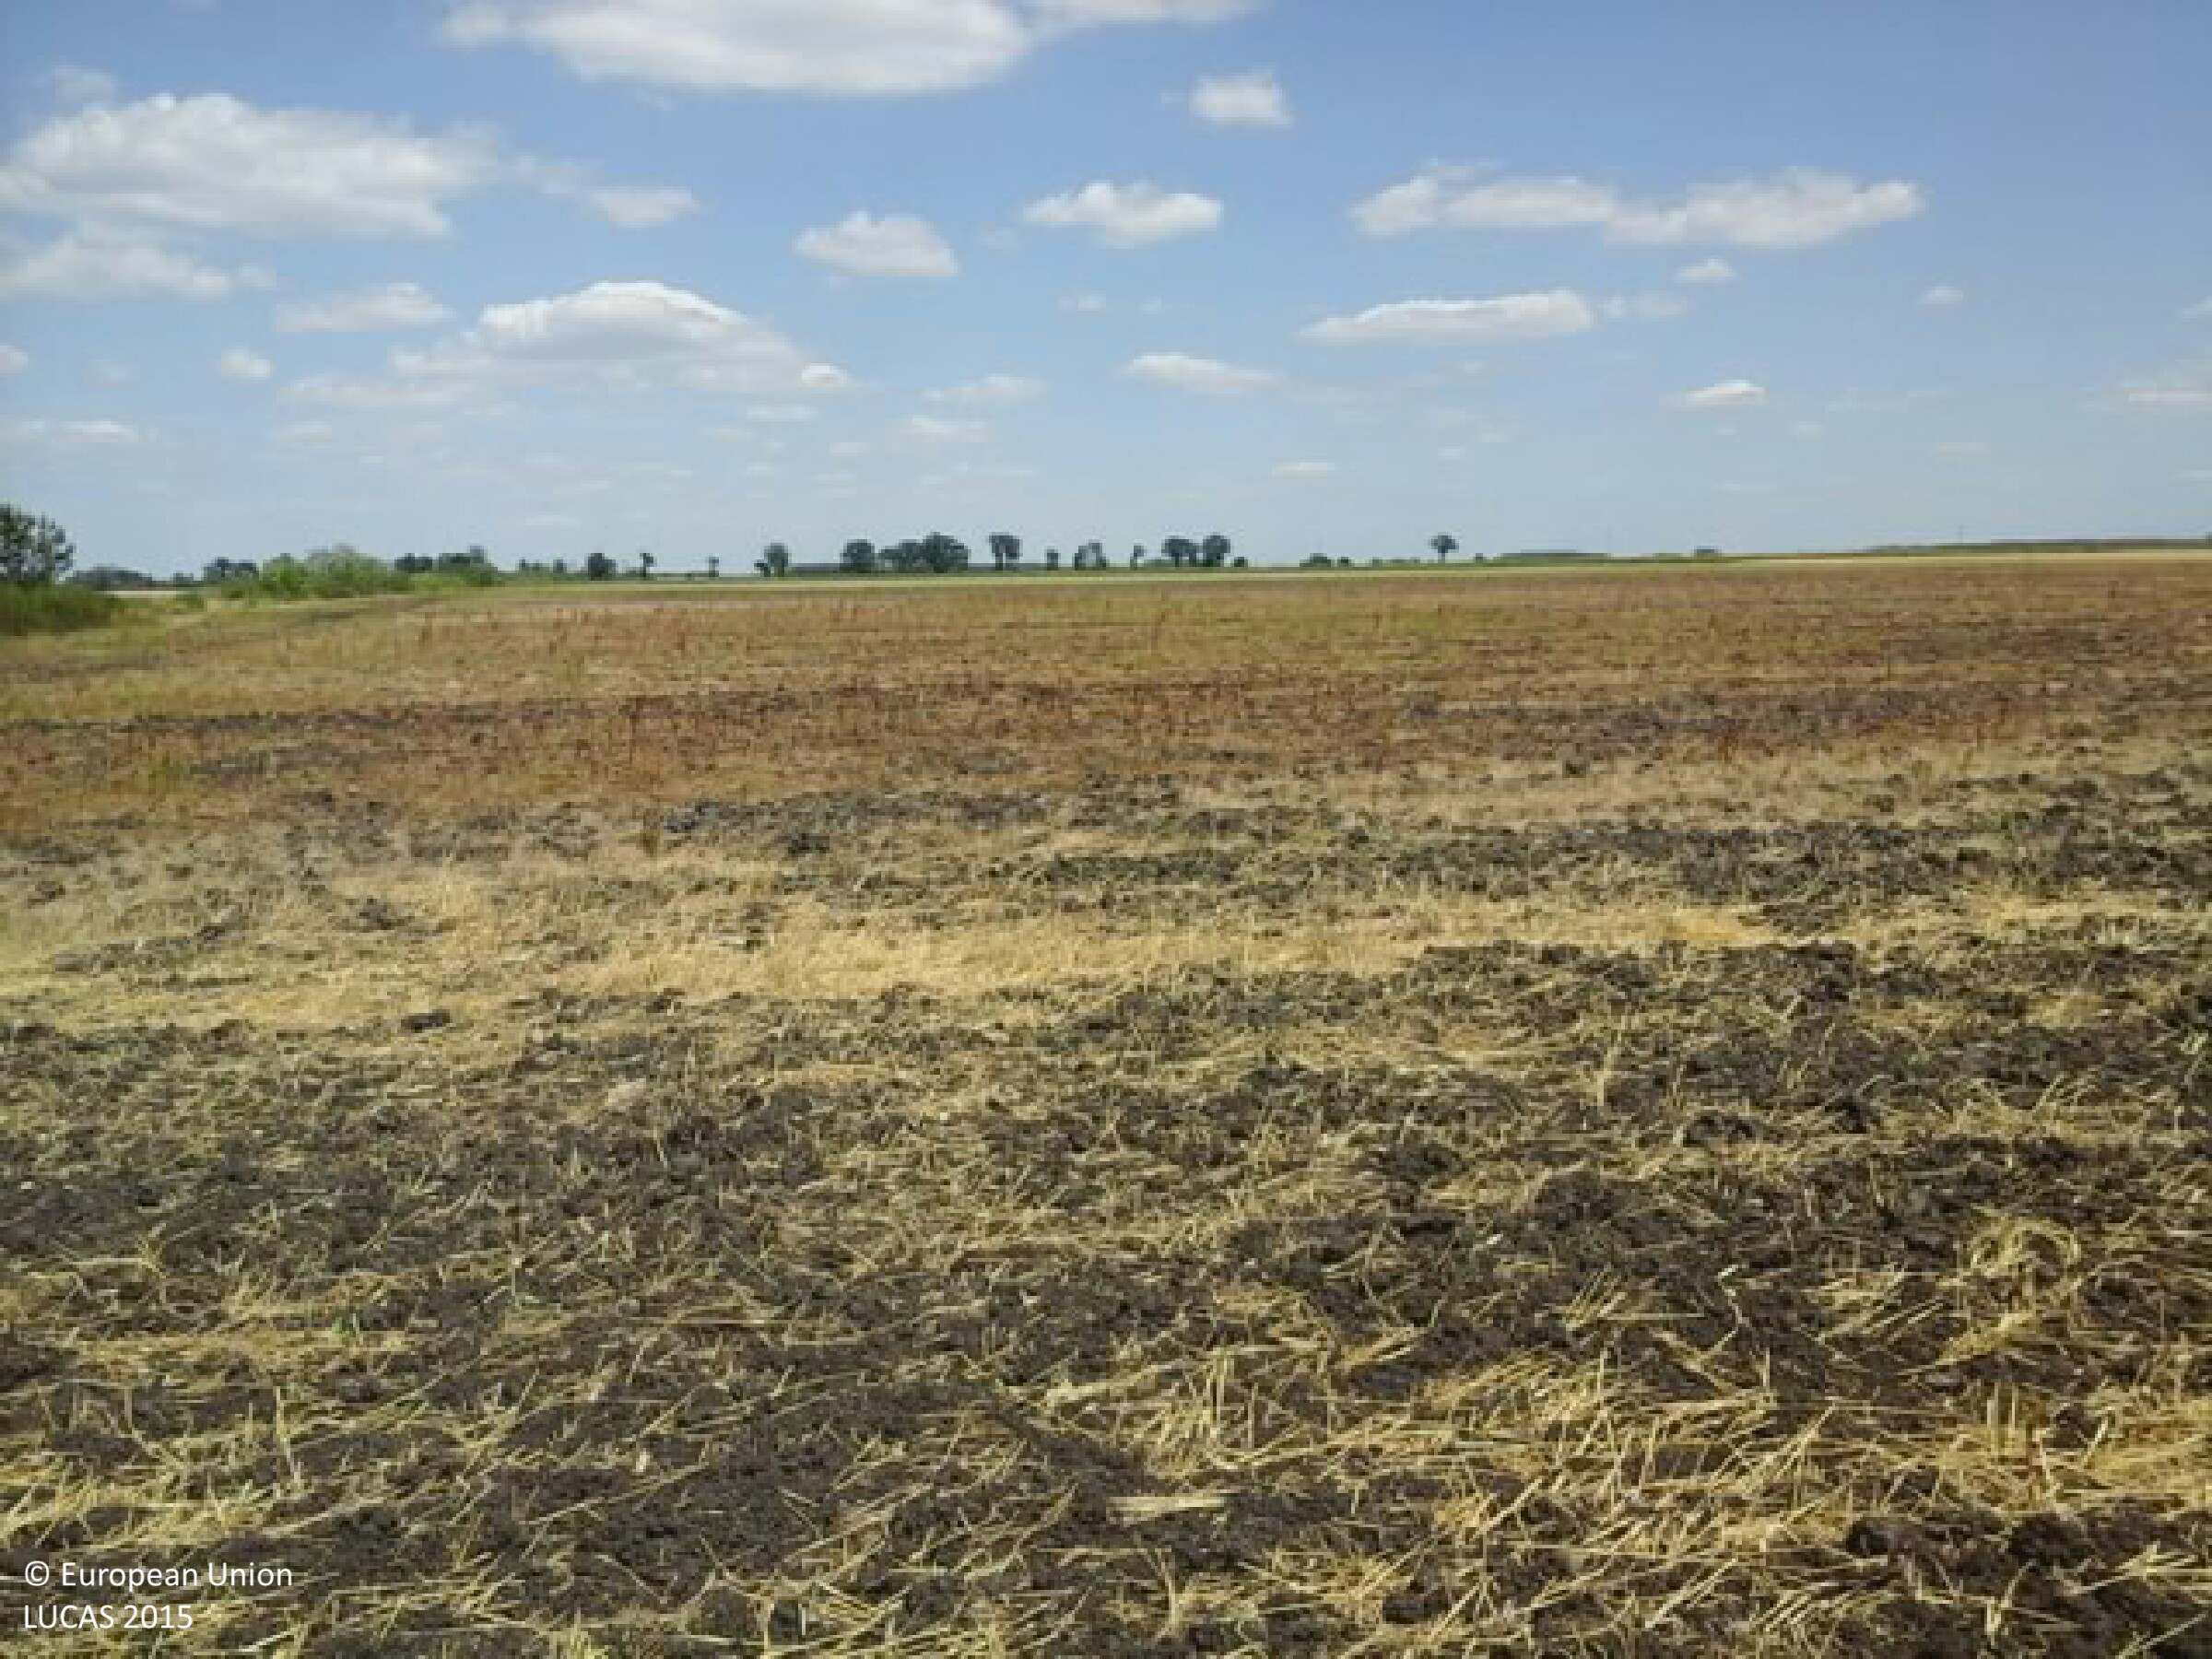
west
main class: Cropland
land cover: Common wheat
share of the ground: < 10 %
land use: Agriculture (excluding fallow land and kitchen gardens)
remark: Harvested field
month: July
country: HU
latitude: 47.6168
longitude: 20.4485
